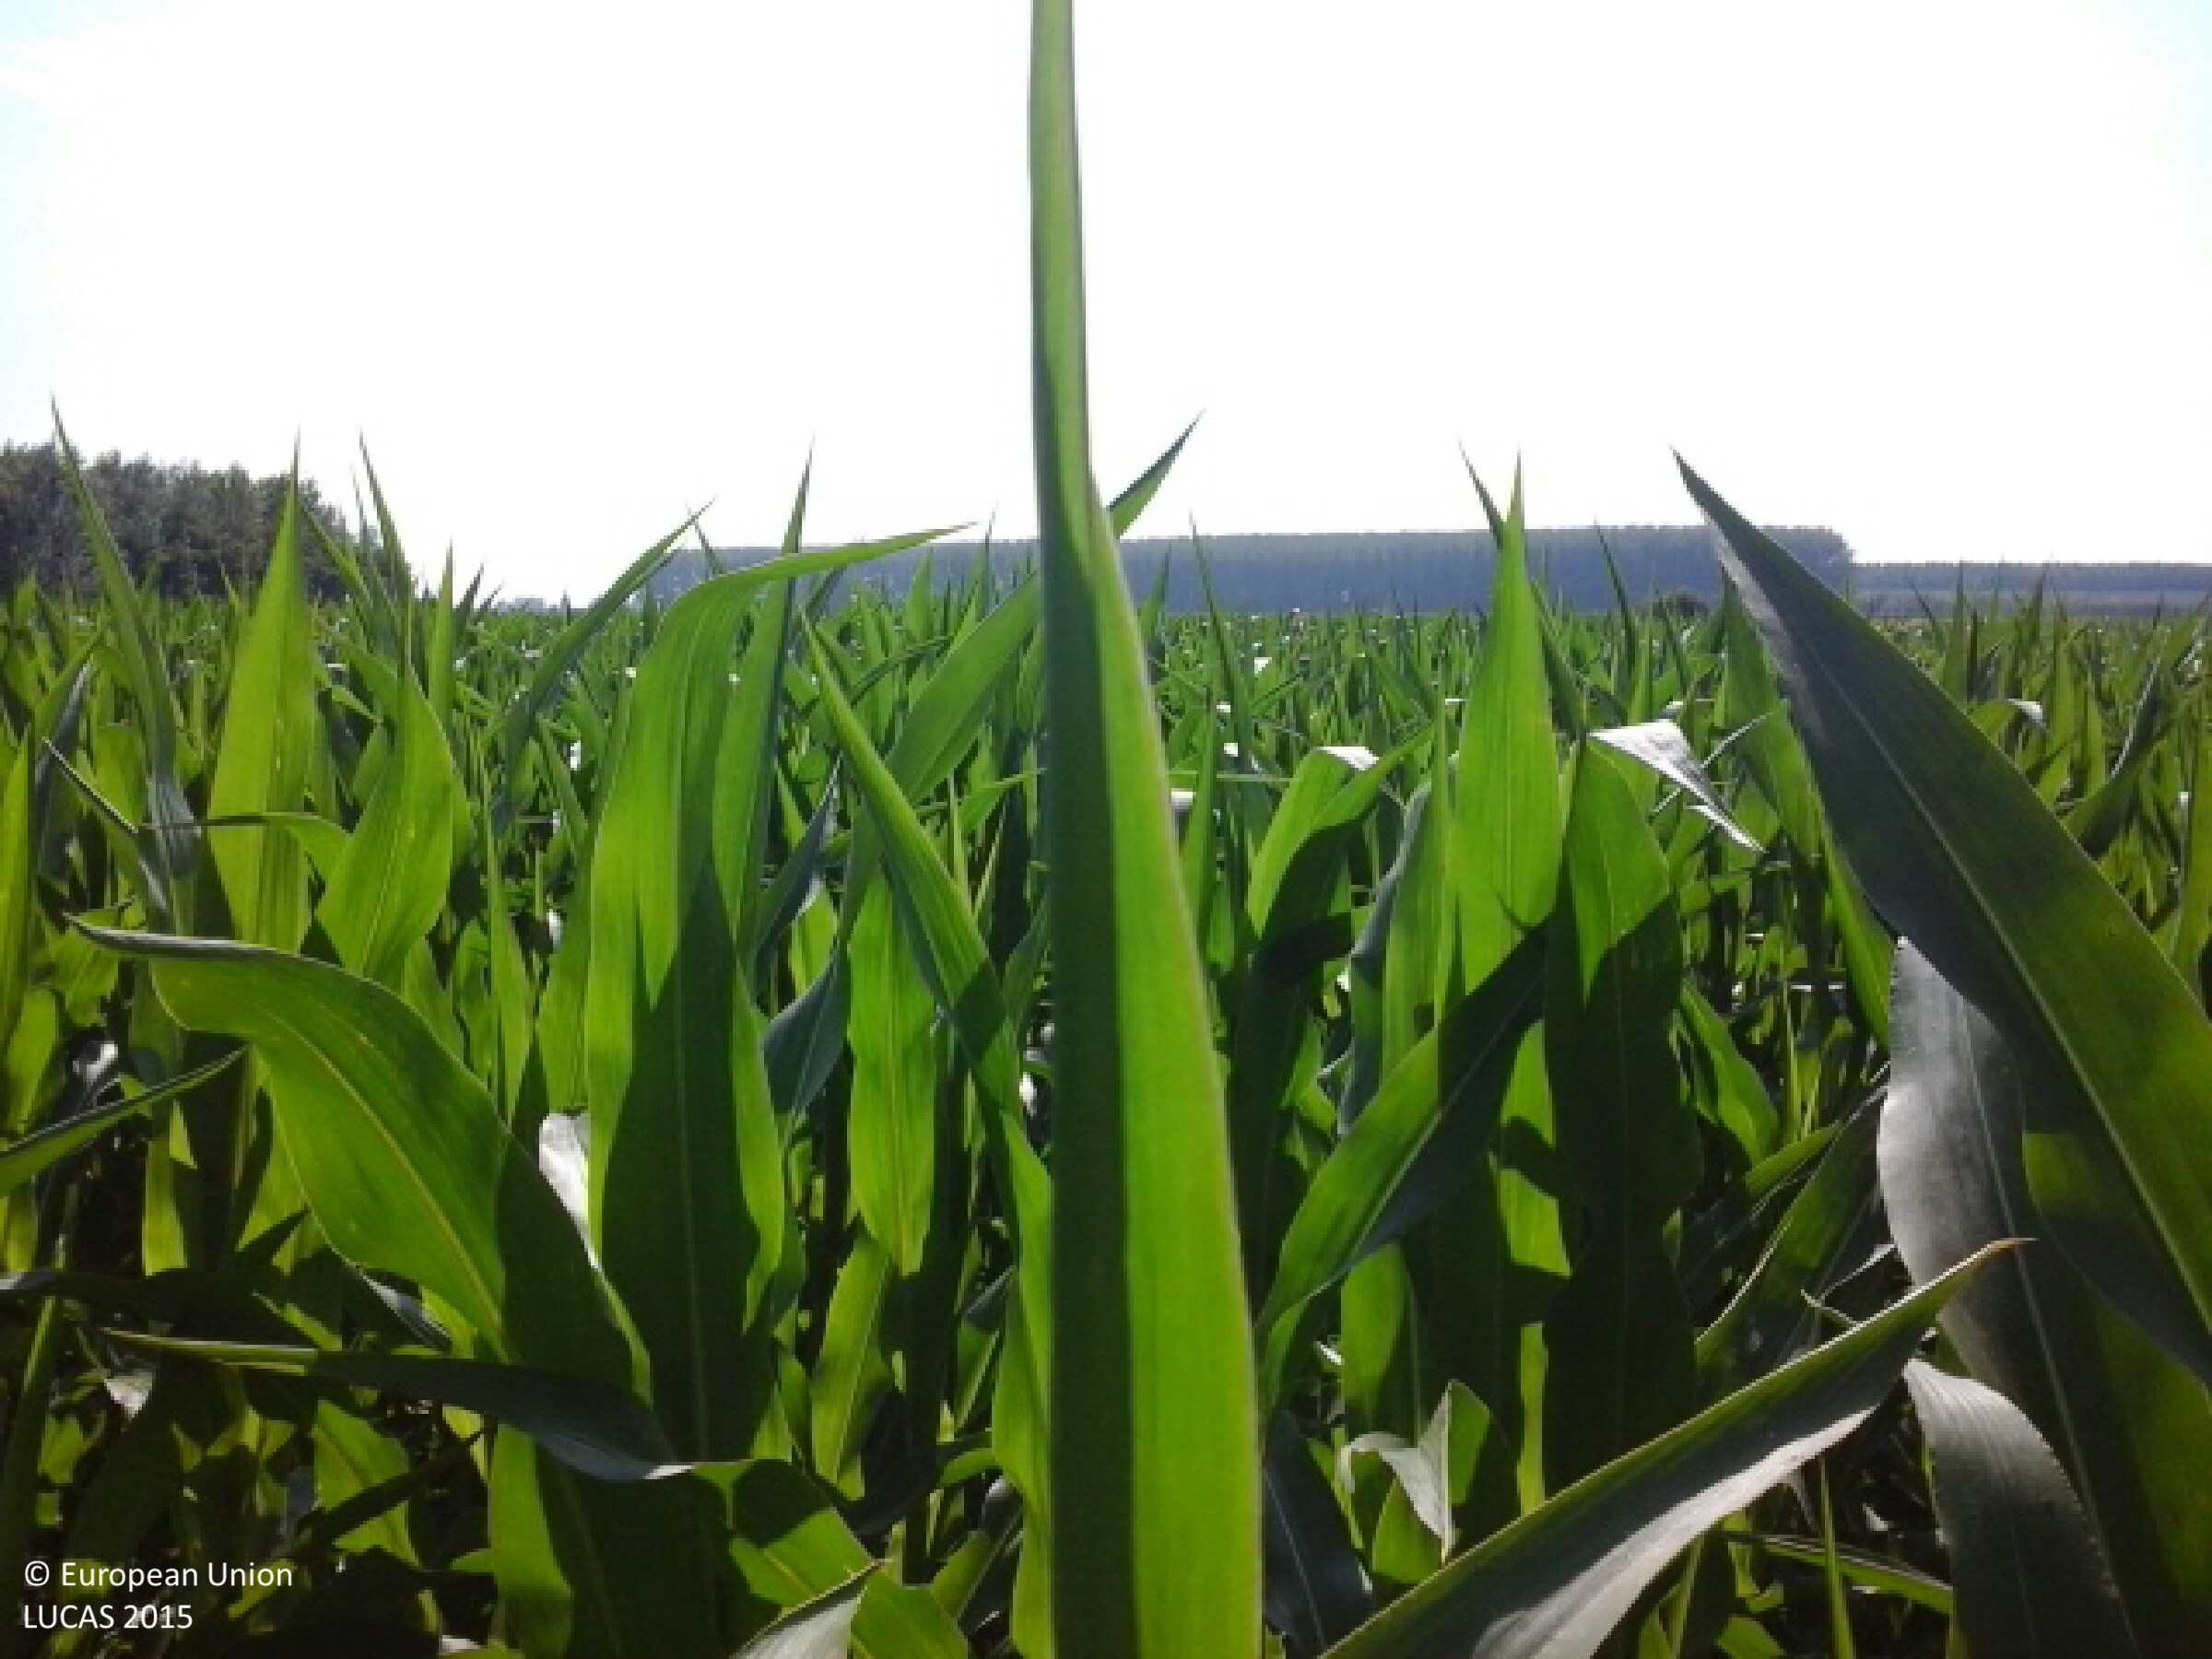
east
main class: Cropland
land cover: Maize
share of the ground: > 75 %
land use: Agriculture (excluding fallow land and kitchen gardens)
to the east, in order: Maize; Triticale; Shruby margins; Tracks; Shruby margins; Ditches and canals; Shruby margins; Maize
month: June
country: HU
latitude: 48.2058
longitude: 21.7972
